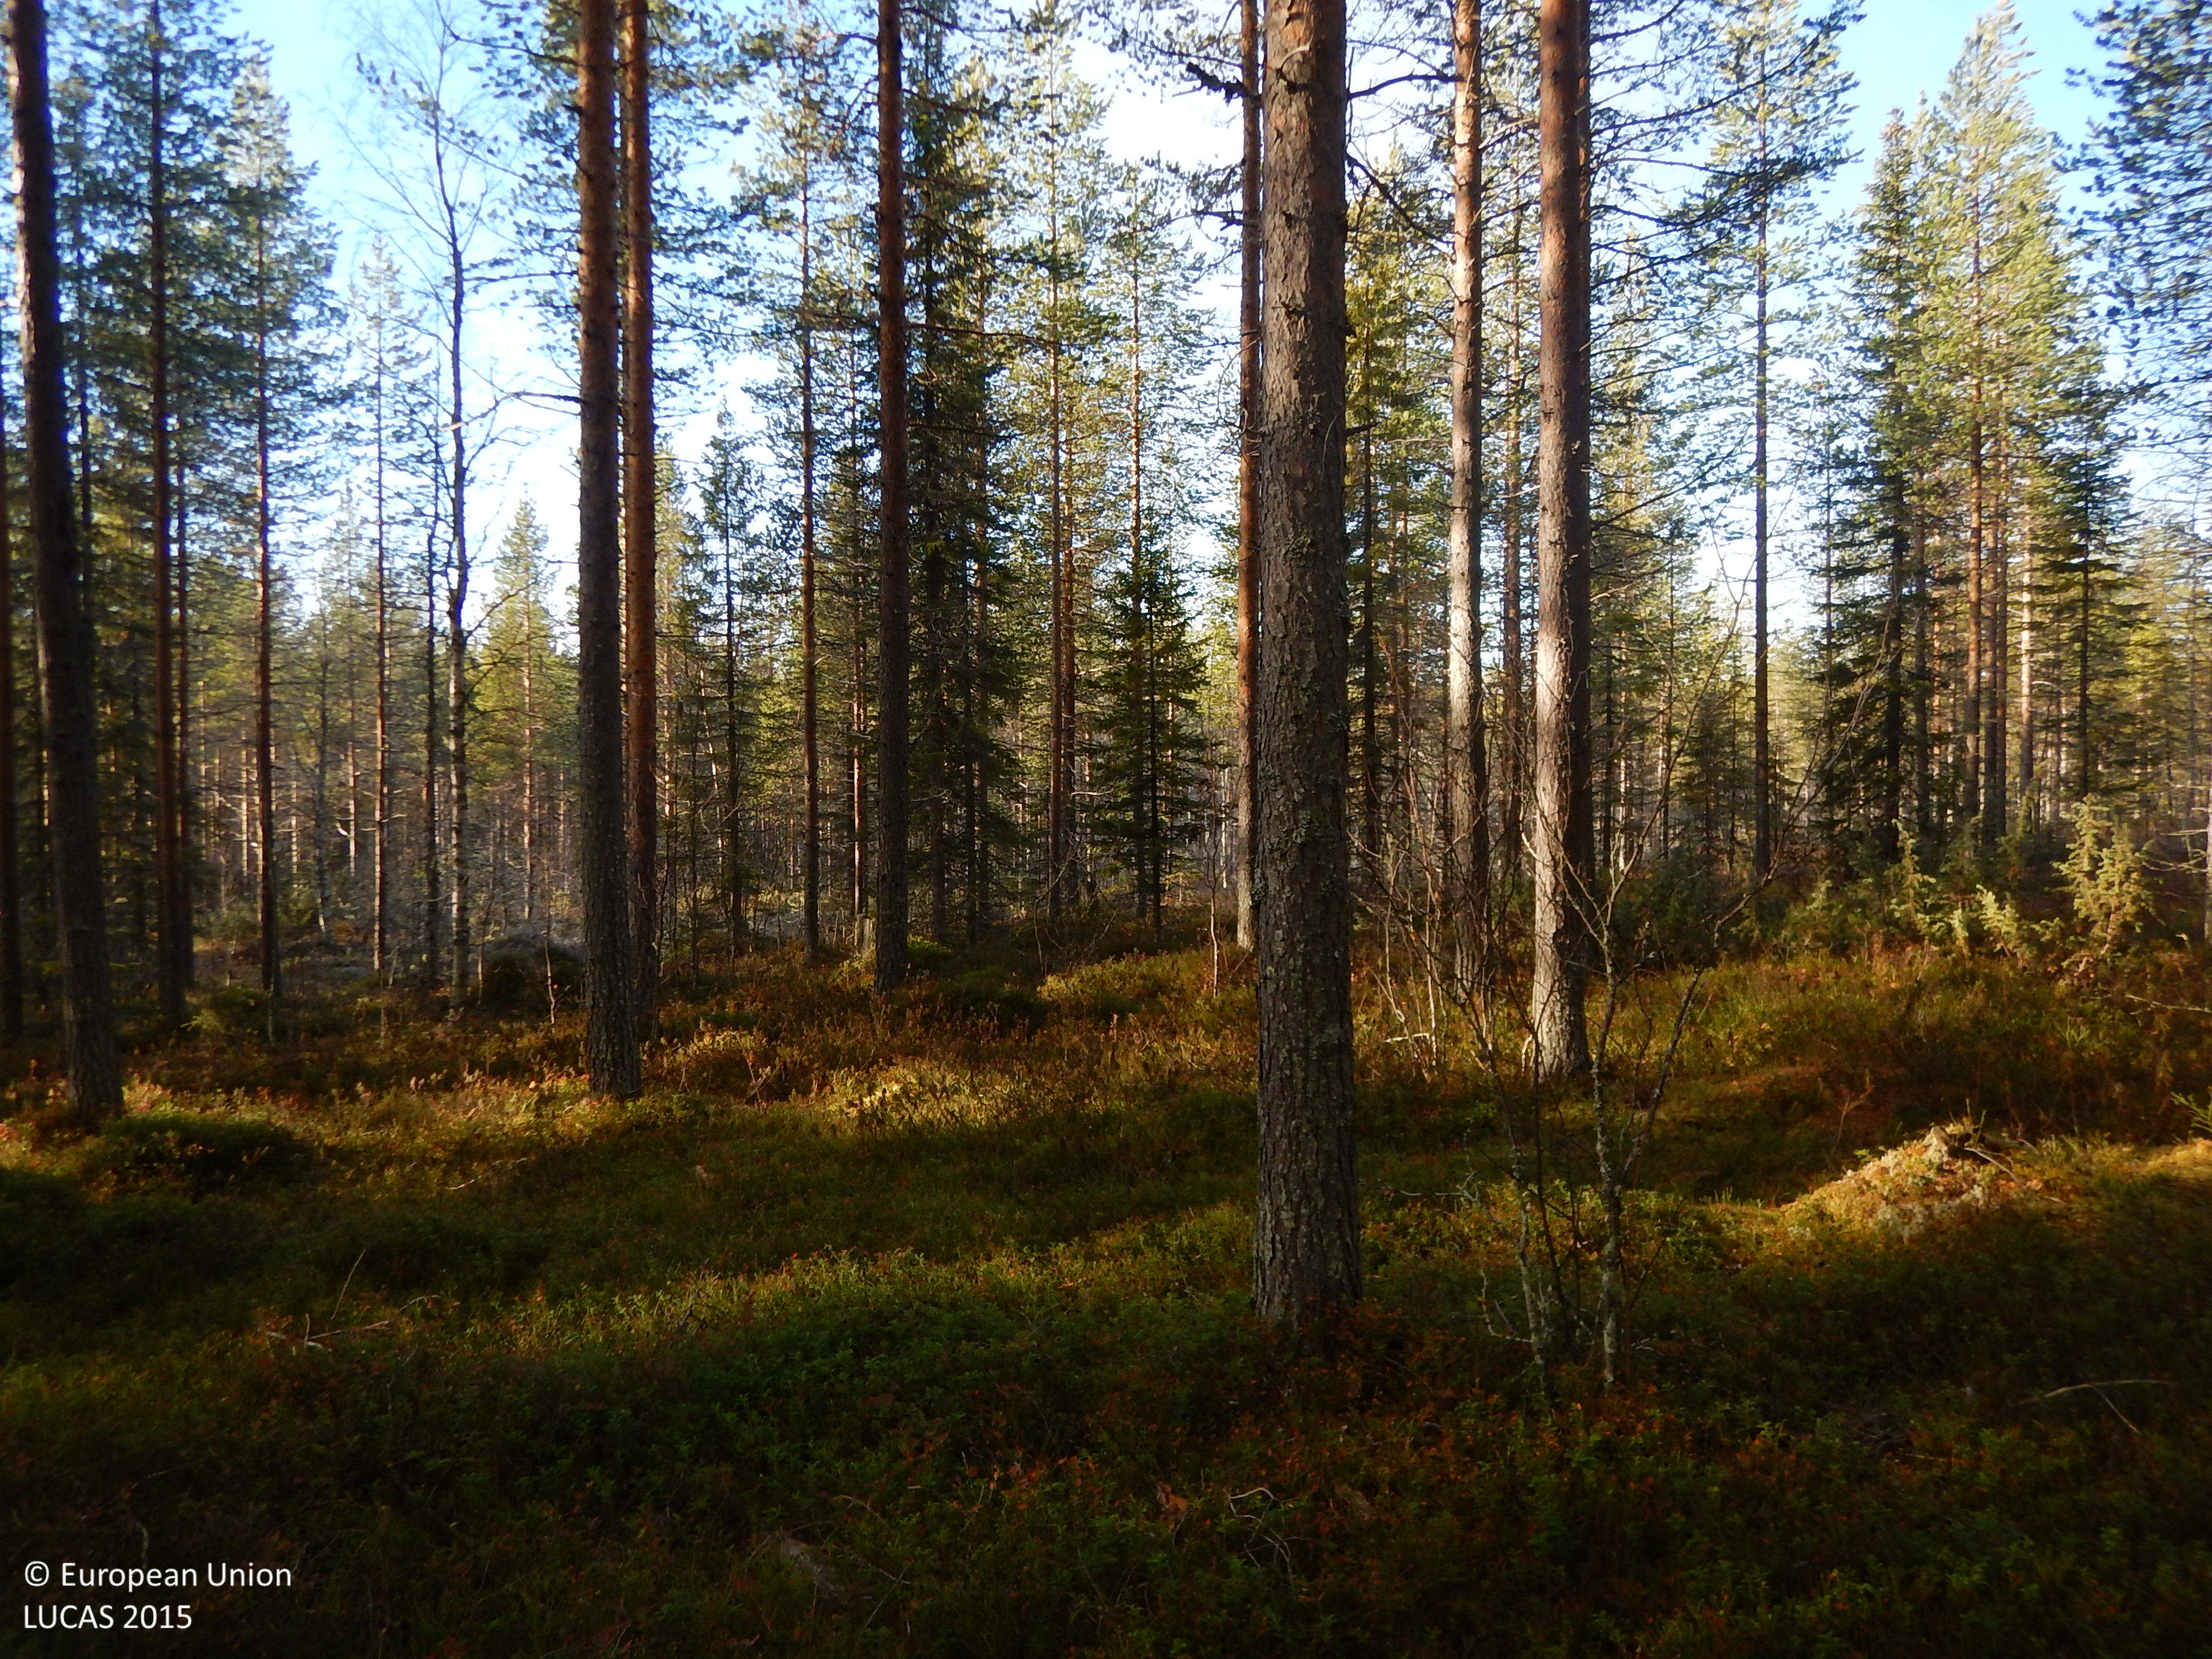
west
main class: Woodland
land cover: Pine dominated coniferous woodland
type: boreal forest
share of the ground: 50 - 75 %
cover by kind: coniferous forest trees 60 %, shrubs 20 %, herbaceous plants 10 %, lichens and mosses 10 %
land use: Forestry
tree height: > 5 m
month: October
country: SE
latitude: 65.0699
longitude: 20.2396
